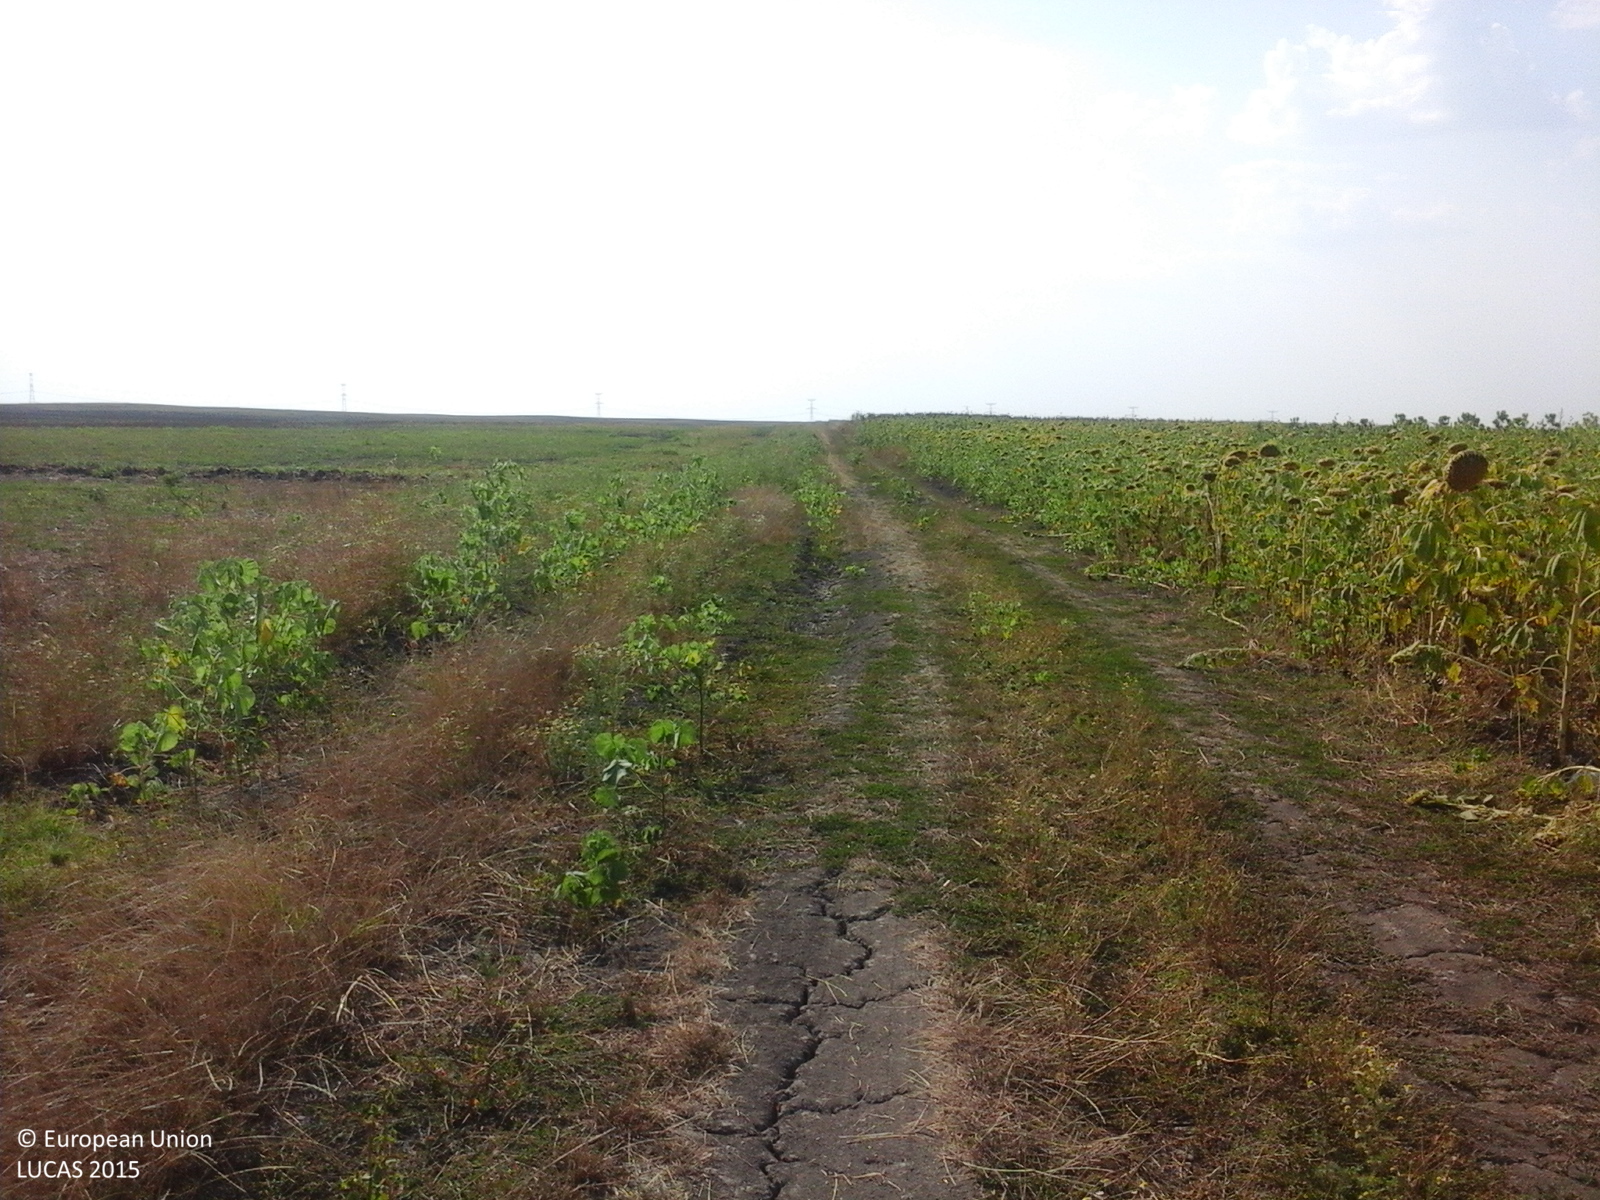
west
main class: Cropland
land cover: Sunflower
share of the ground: > 75 %
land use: Agriculture (excluding fallow land and kitchen gardens)
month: August
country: RO
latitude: 43.8607
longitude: 23.6745
